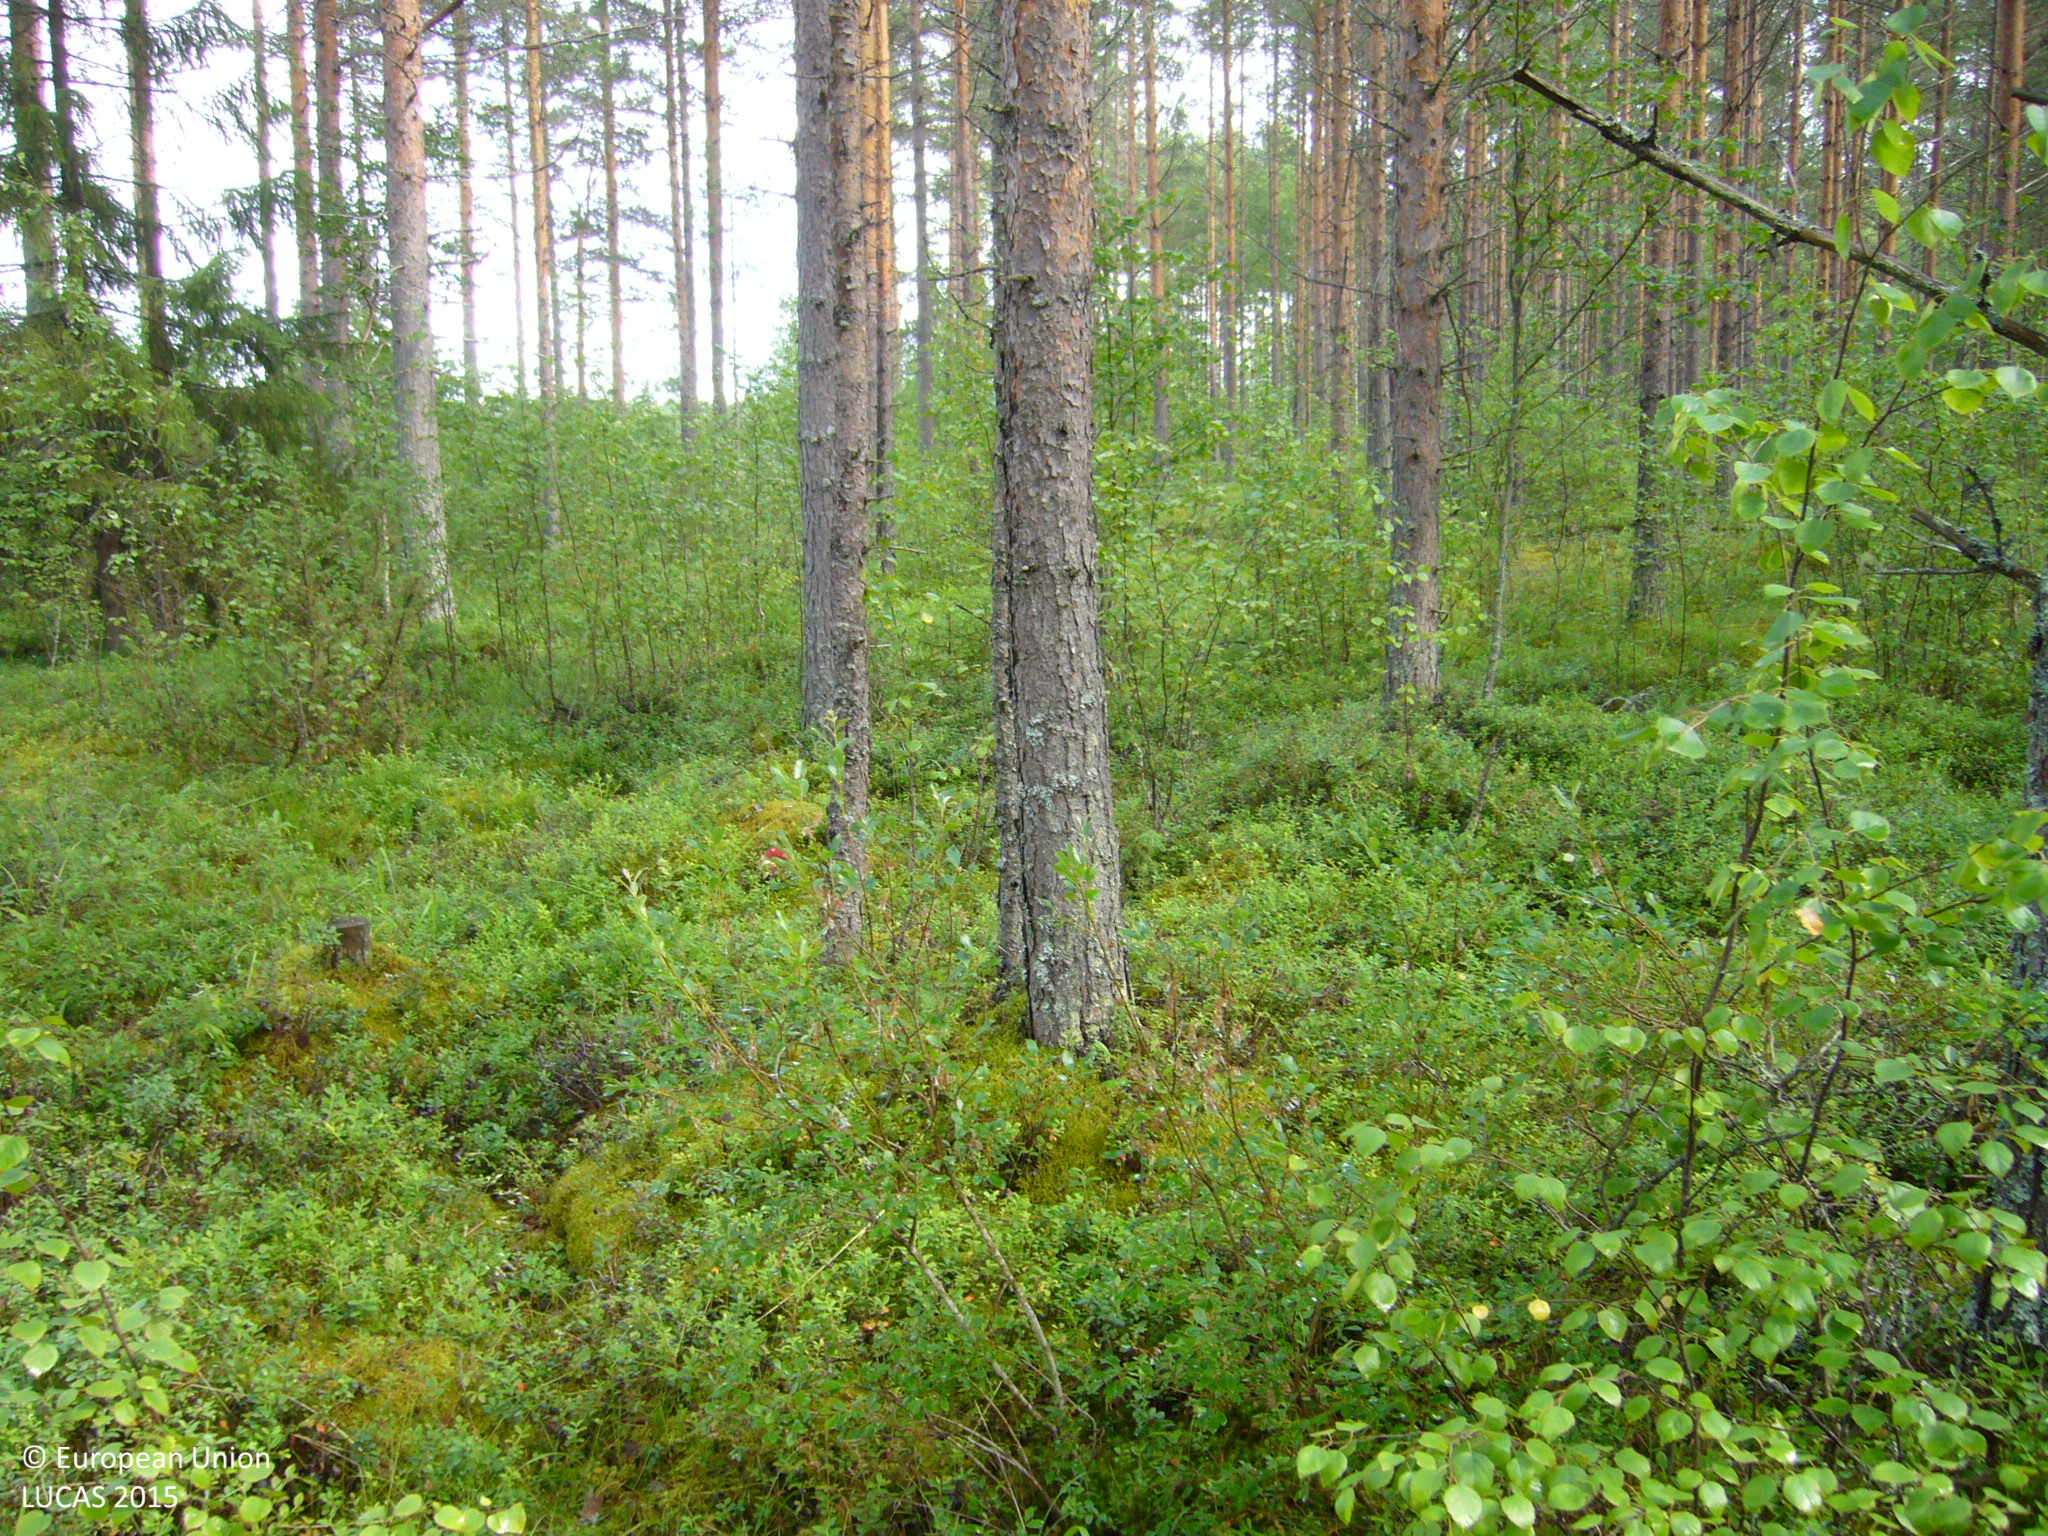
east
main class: Woodland
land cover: Pine dominated mixed woodland
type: boreal forest
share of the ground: > 75 %
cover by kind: coniferous forest trees 50 %, broadleaved forest trees 30 %, shrubs 20 %
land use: Forestry
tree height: > 5 m
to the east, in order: Pine dominated mixed woodland; Other mixed woodland; Ditches and canals; Spontaneously vegetated surfaces; Barley; Ditches and canals; Barley
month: July
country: FI
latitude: 63.9723
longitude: 25.7689
